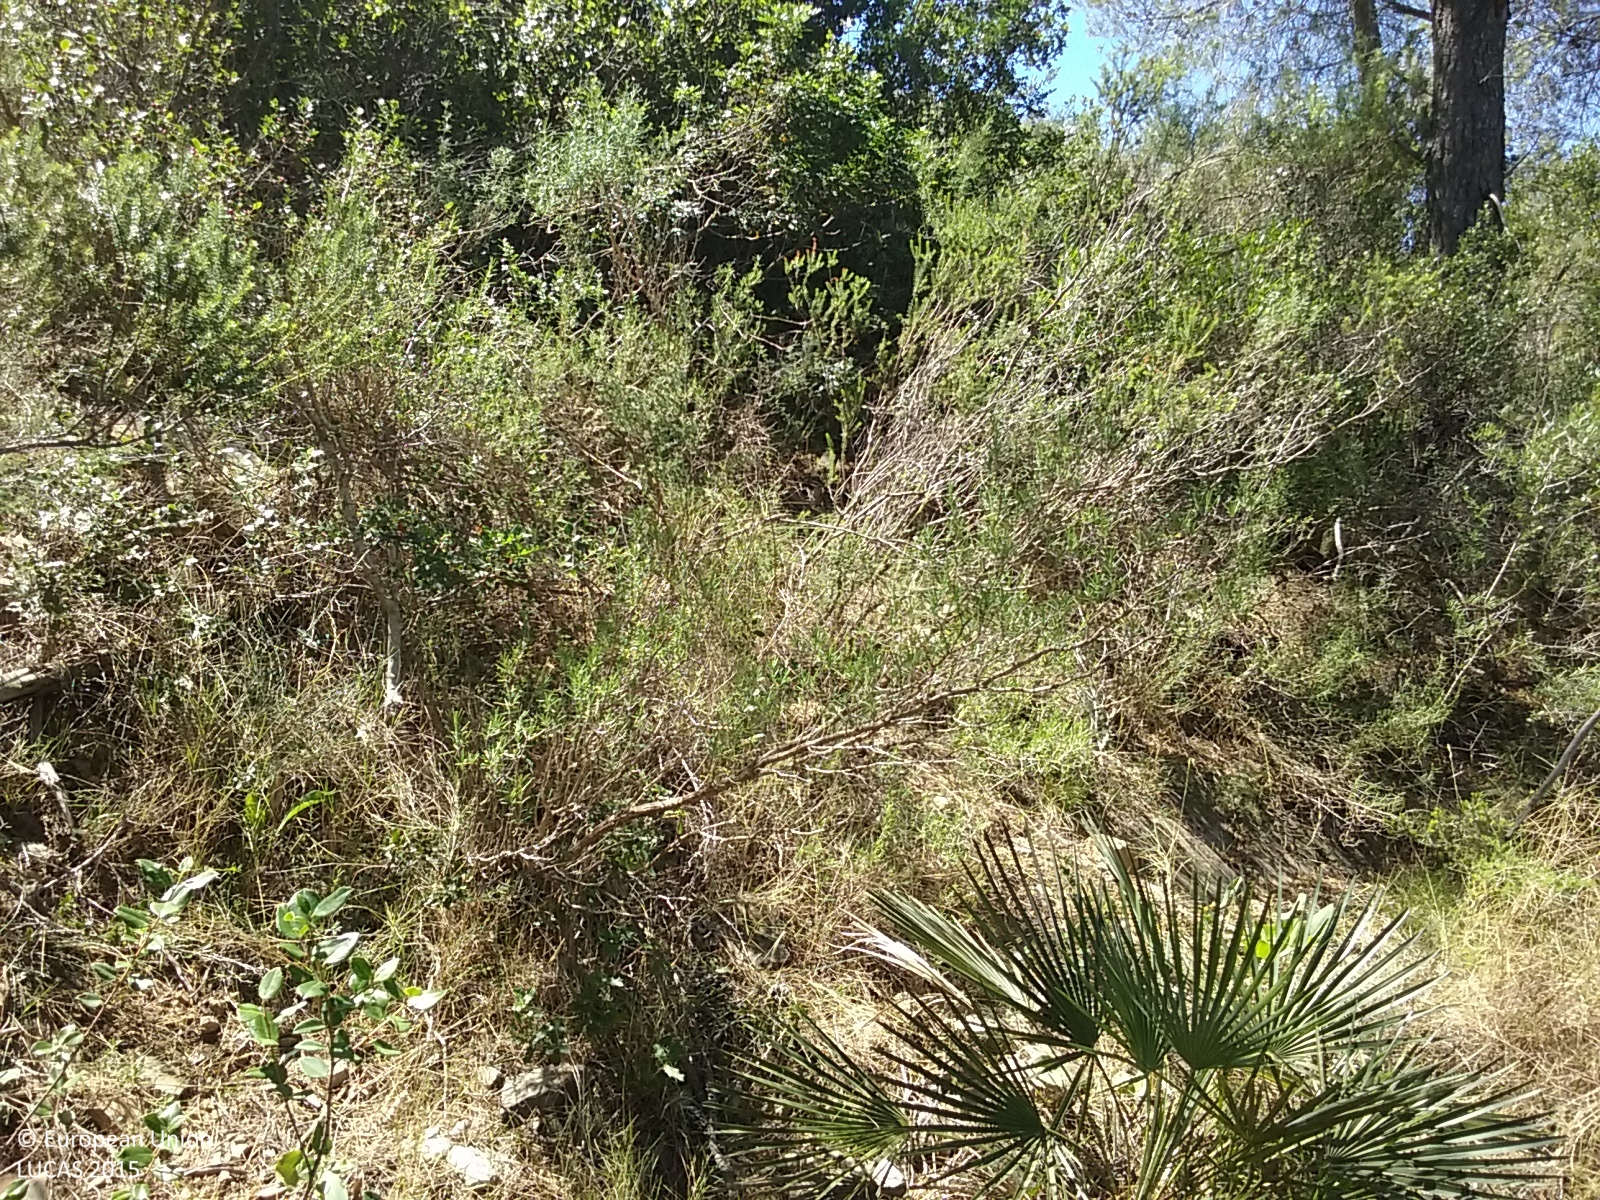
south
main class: Woodland
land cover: Pine dominated coniferous woodland
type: coniferous forest of the mediterranean region
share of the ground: 50 - 75 %
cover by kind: coniferous forest trees 55 %, herbaceous plants 25 %, shrubs 20 %
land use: Semi-natural and natural areas not in use
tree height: > 5 m
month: June
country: ES
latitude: 40.9902
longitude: 0.5186
